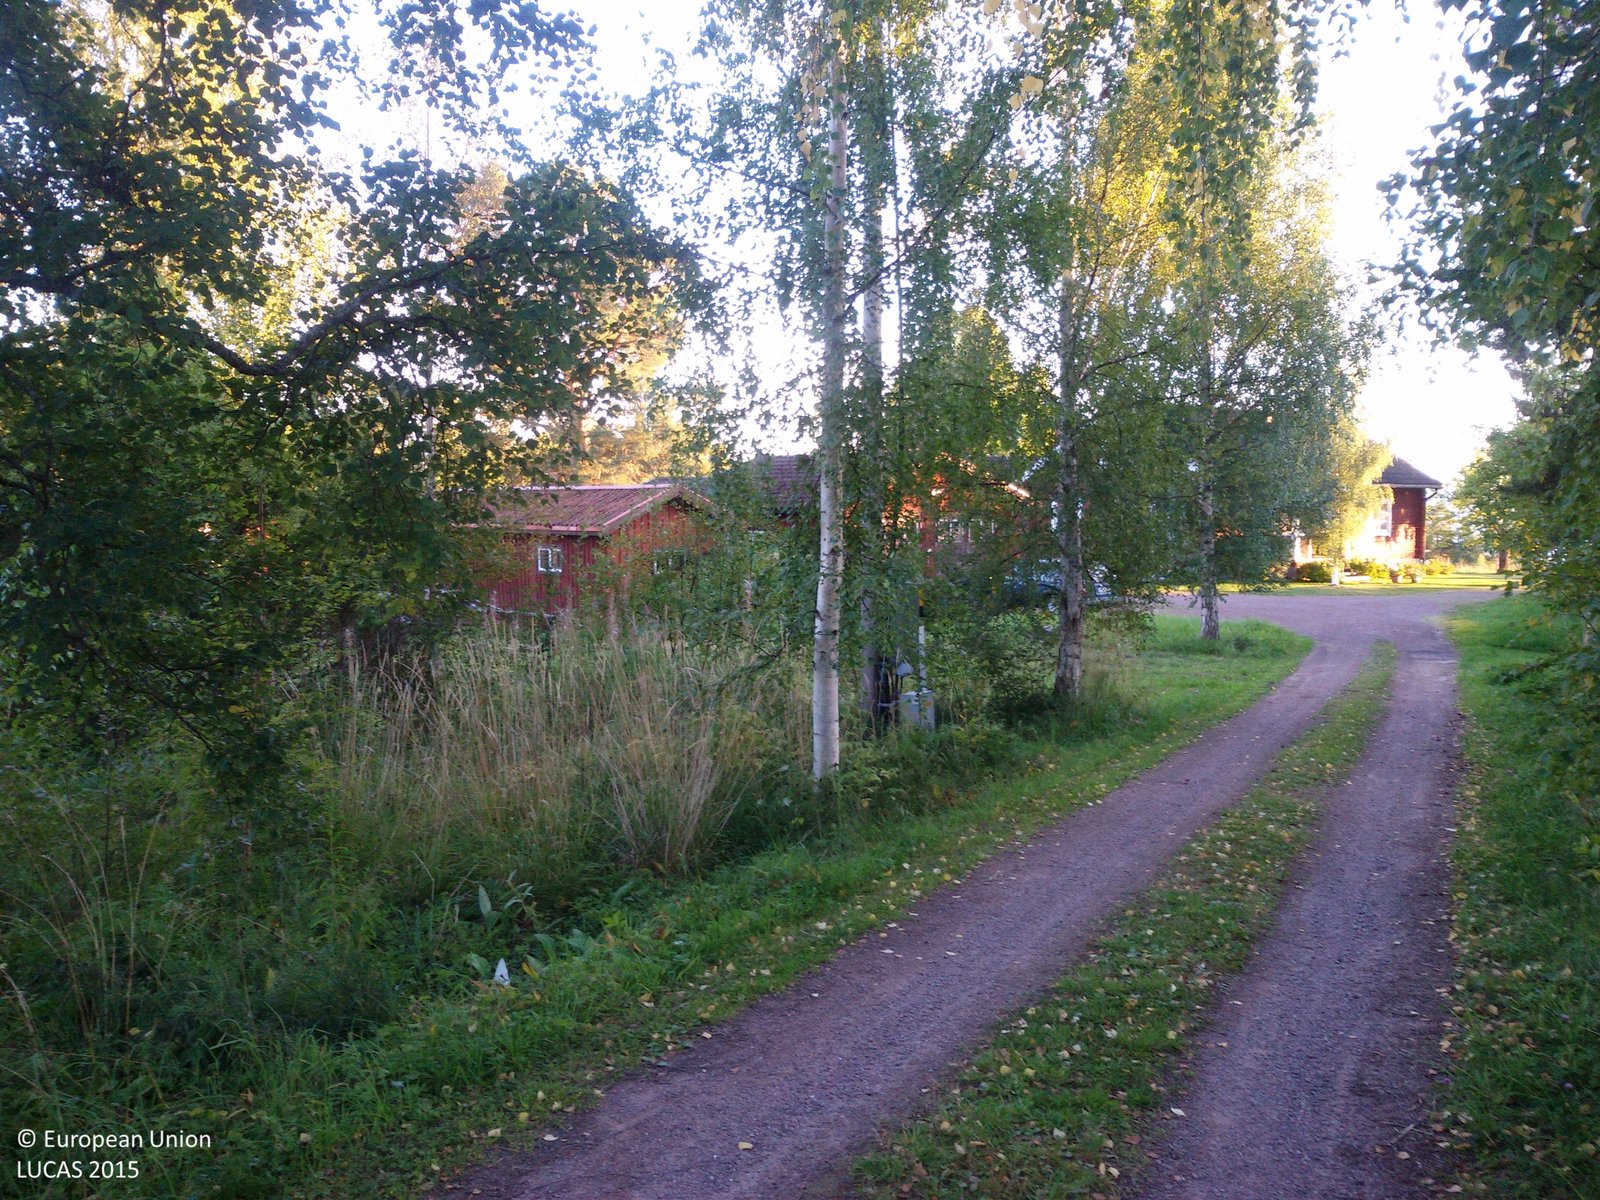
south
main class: Grassland
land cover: Grassland without tree/shrub cover
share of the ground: > 75 %
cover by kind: herbaceous plants 100 %
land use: Residential
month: September
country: SE
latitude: 60.9021
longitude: 15.0558
